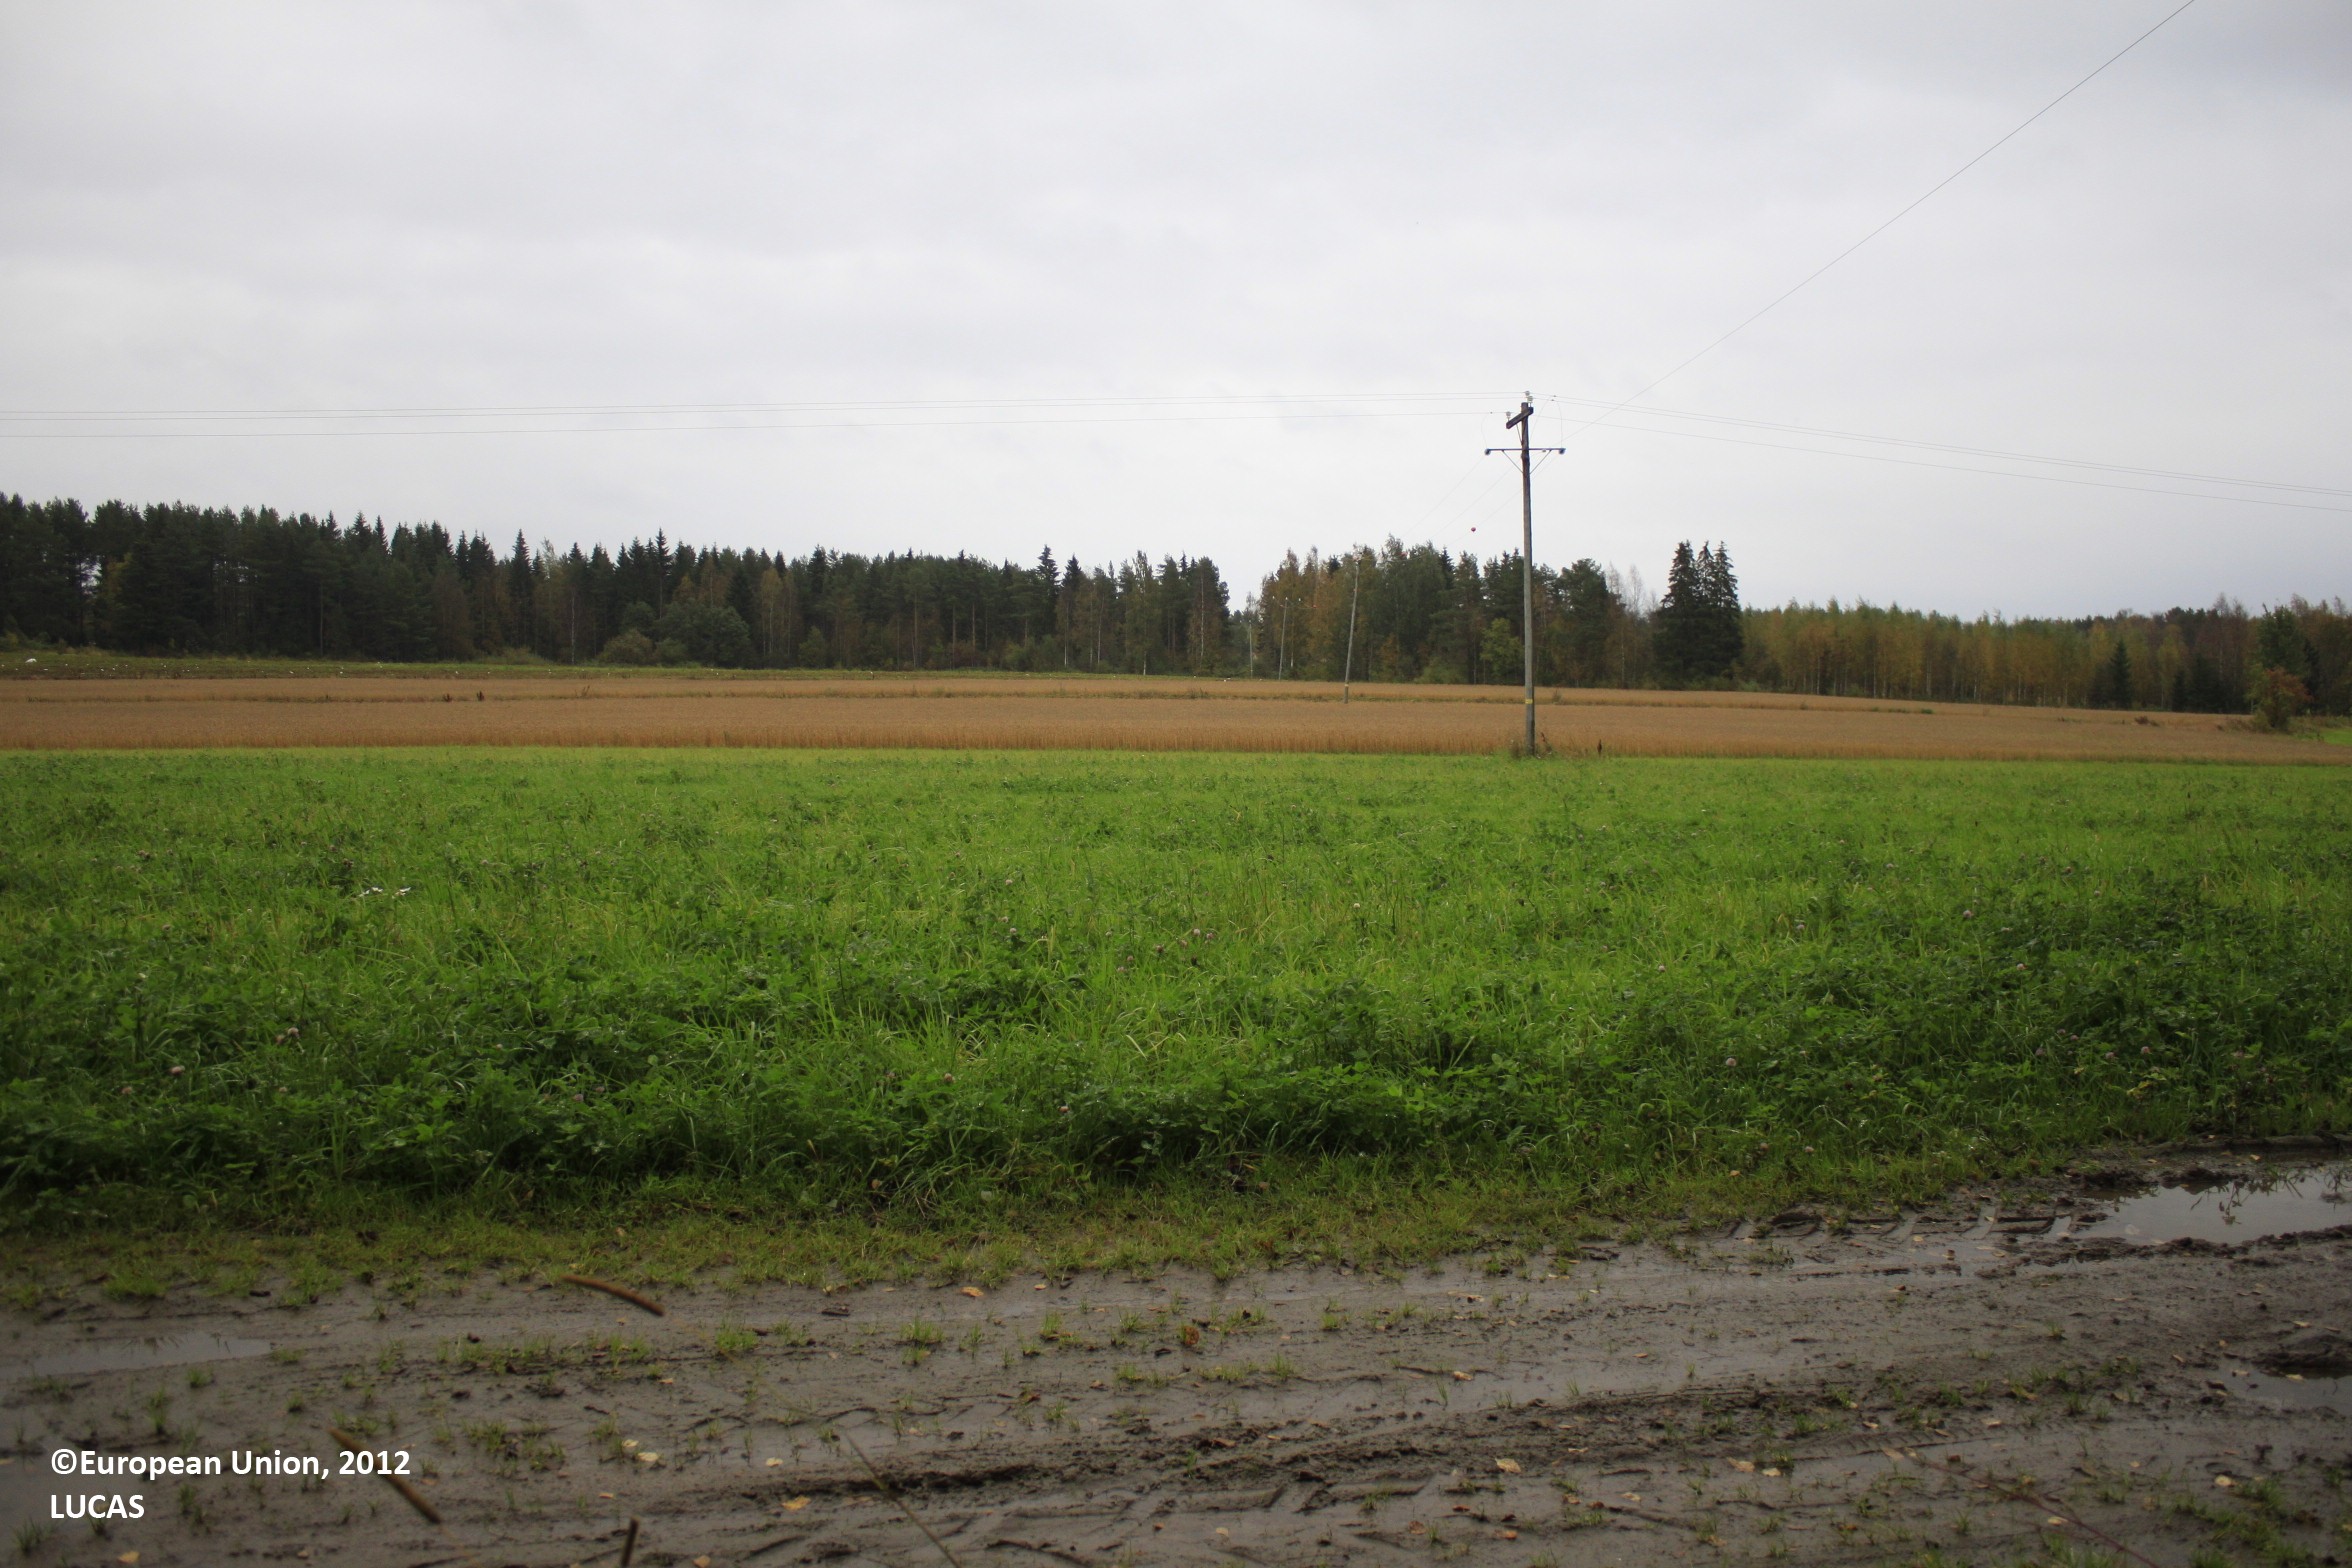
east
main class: Woodland
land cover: Spruce dominated mixed woodland
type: boreal forest
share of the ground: 50 - 75 %
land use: Forestry
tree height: > 5 m
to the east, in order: Spruce dominated mixed woodland; Ditches and canals; Tracks; Clovers; Grassland without tree/shrub cover; Electric lines; Grassland without tree/shrub cover; Common wheat; Strawberries; Common wheat; Strawberries
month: September
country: FI
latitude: 63.6559
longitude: 25.9663
